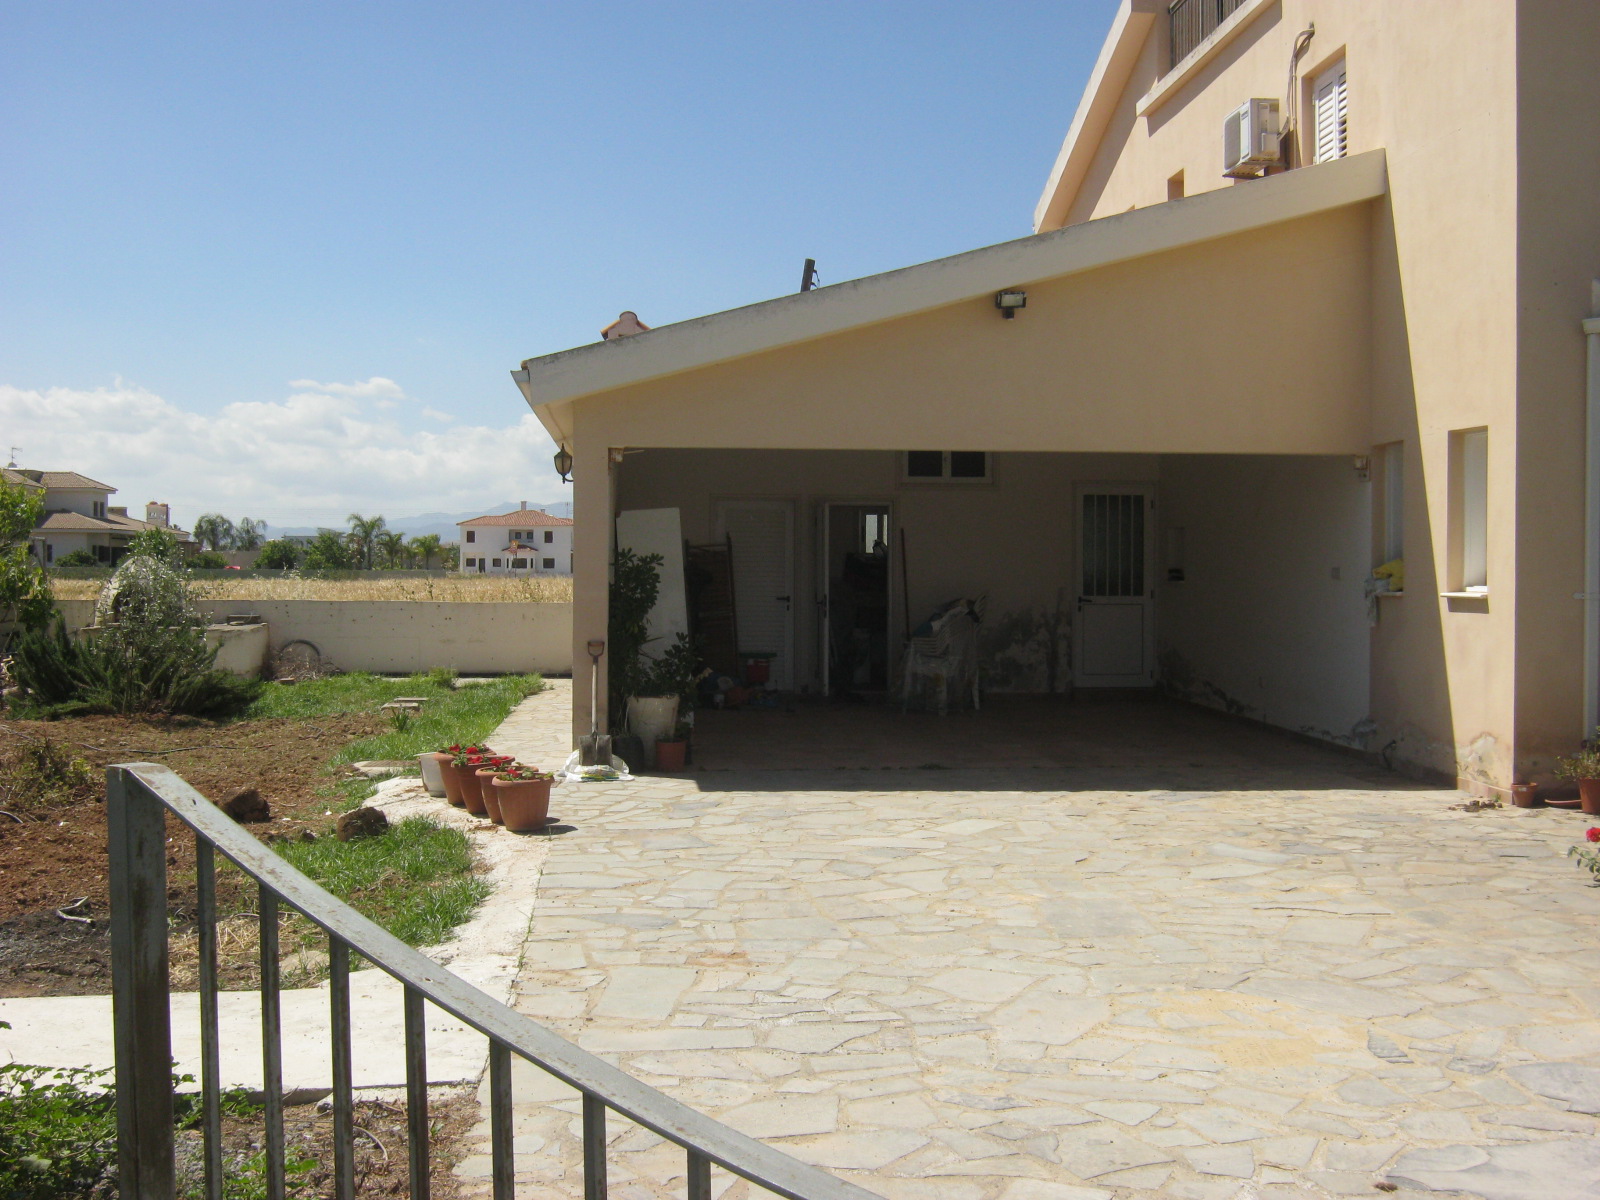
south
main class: Artificial land
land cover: Non built-up linear features
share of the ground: > 75 %
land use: Road transport
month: May
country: CY
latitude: 35.1536
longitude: 33.2066
